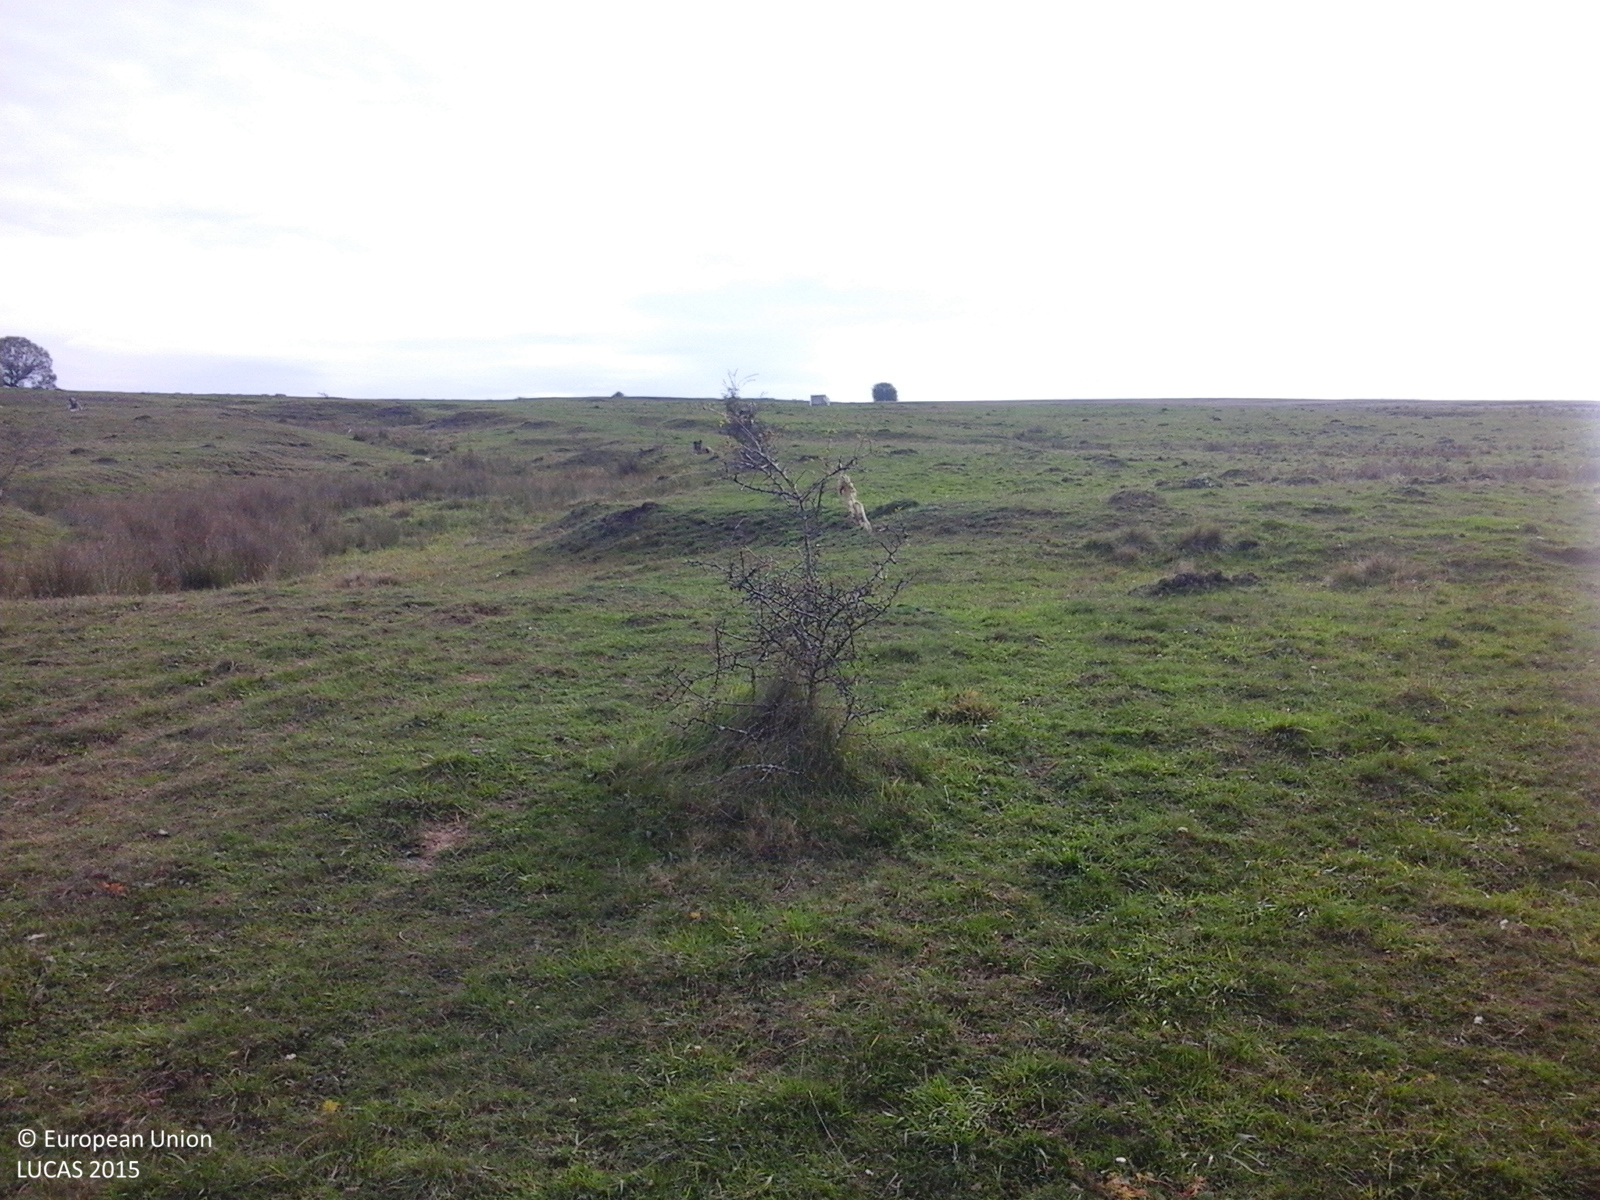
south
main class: Grassland
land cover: Grassland without tree/shrub cover
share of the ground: > 75 %
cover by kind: herbaceous plants 100 %
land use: Agriculture (excluding fallow land and kitchen gardens)
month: October
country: RO
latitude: 45.9849
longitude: 24.9771
